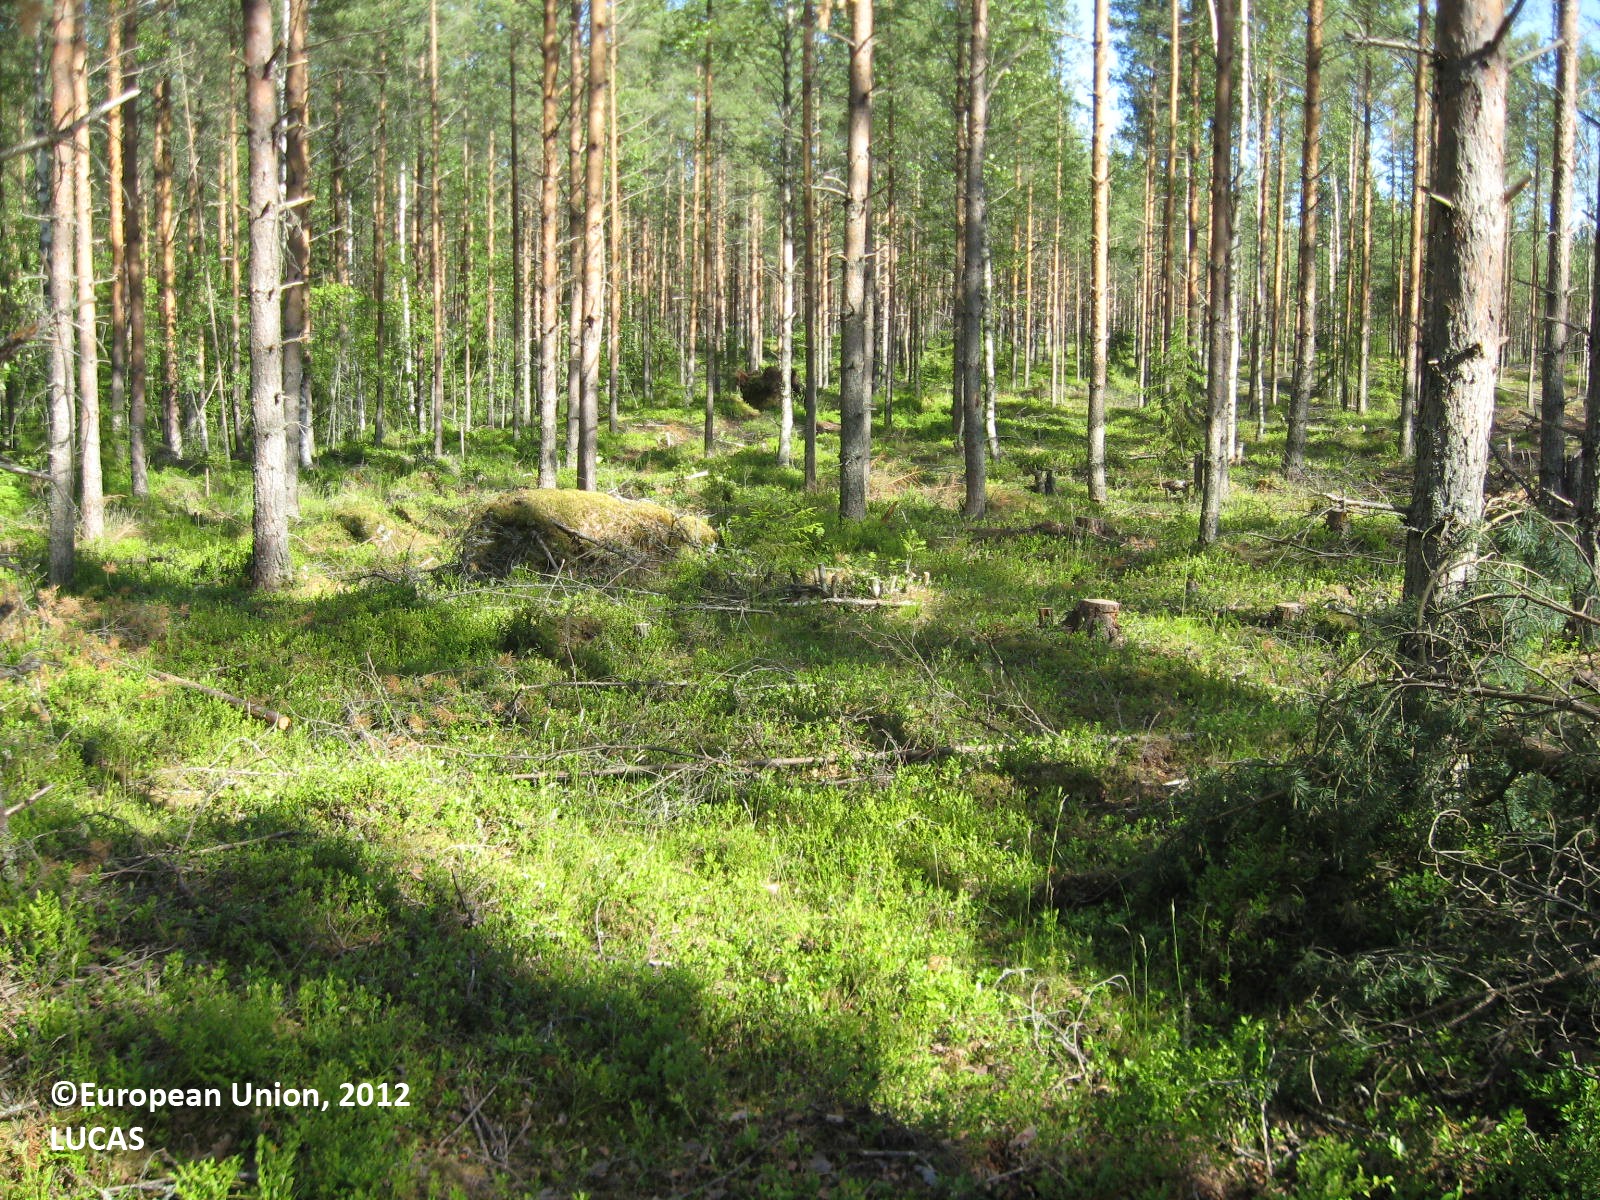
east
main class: Woodland
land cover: Pine dominated coniferous woodland
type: boreal forest
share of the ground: > 75 %
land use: Forestry
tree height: > 5 m
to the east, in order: Pine dominated coniferous woodland; Spruce dominated coniferous woodland; Pine dominated coniferous woodland
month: June
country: FI
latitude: 62.8183
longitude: 22.7520
